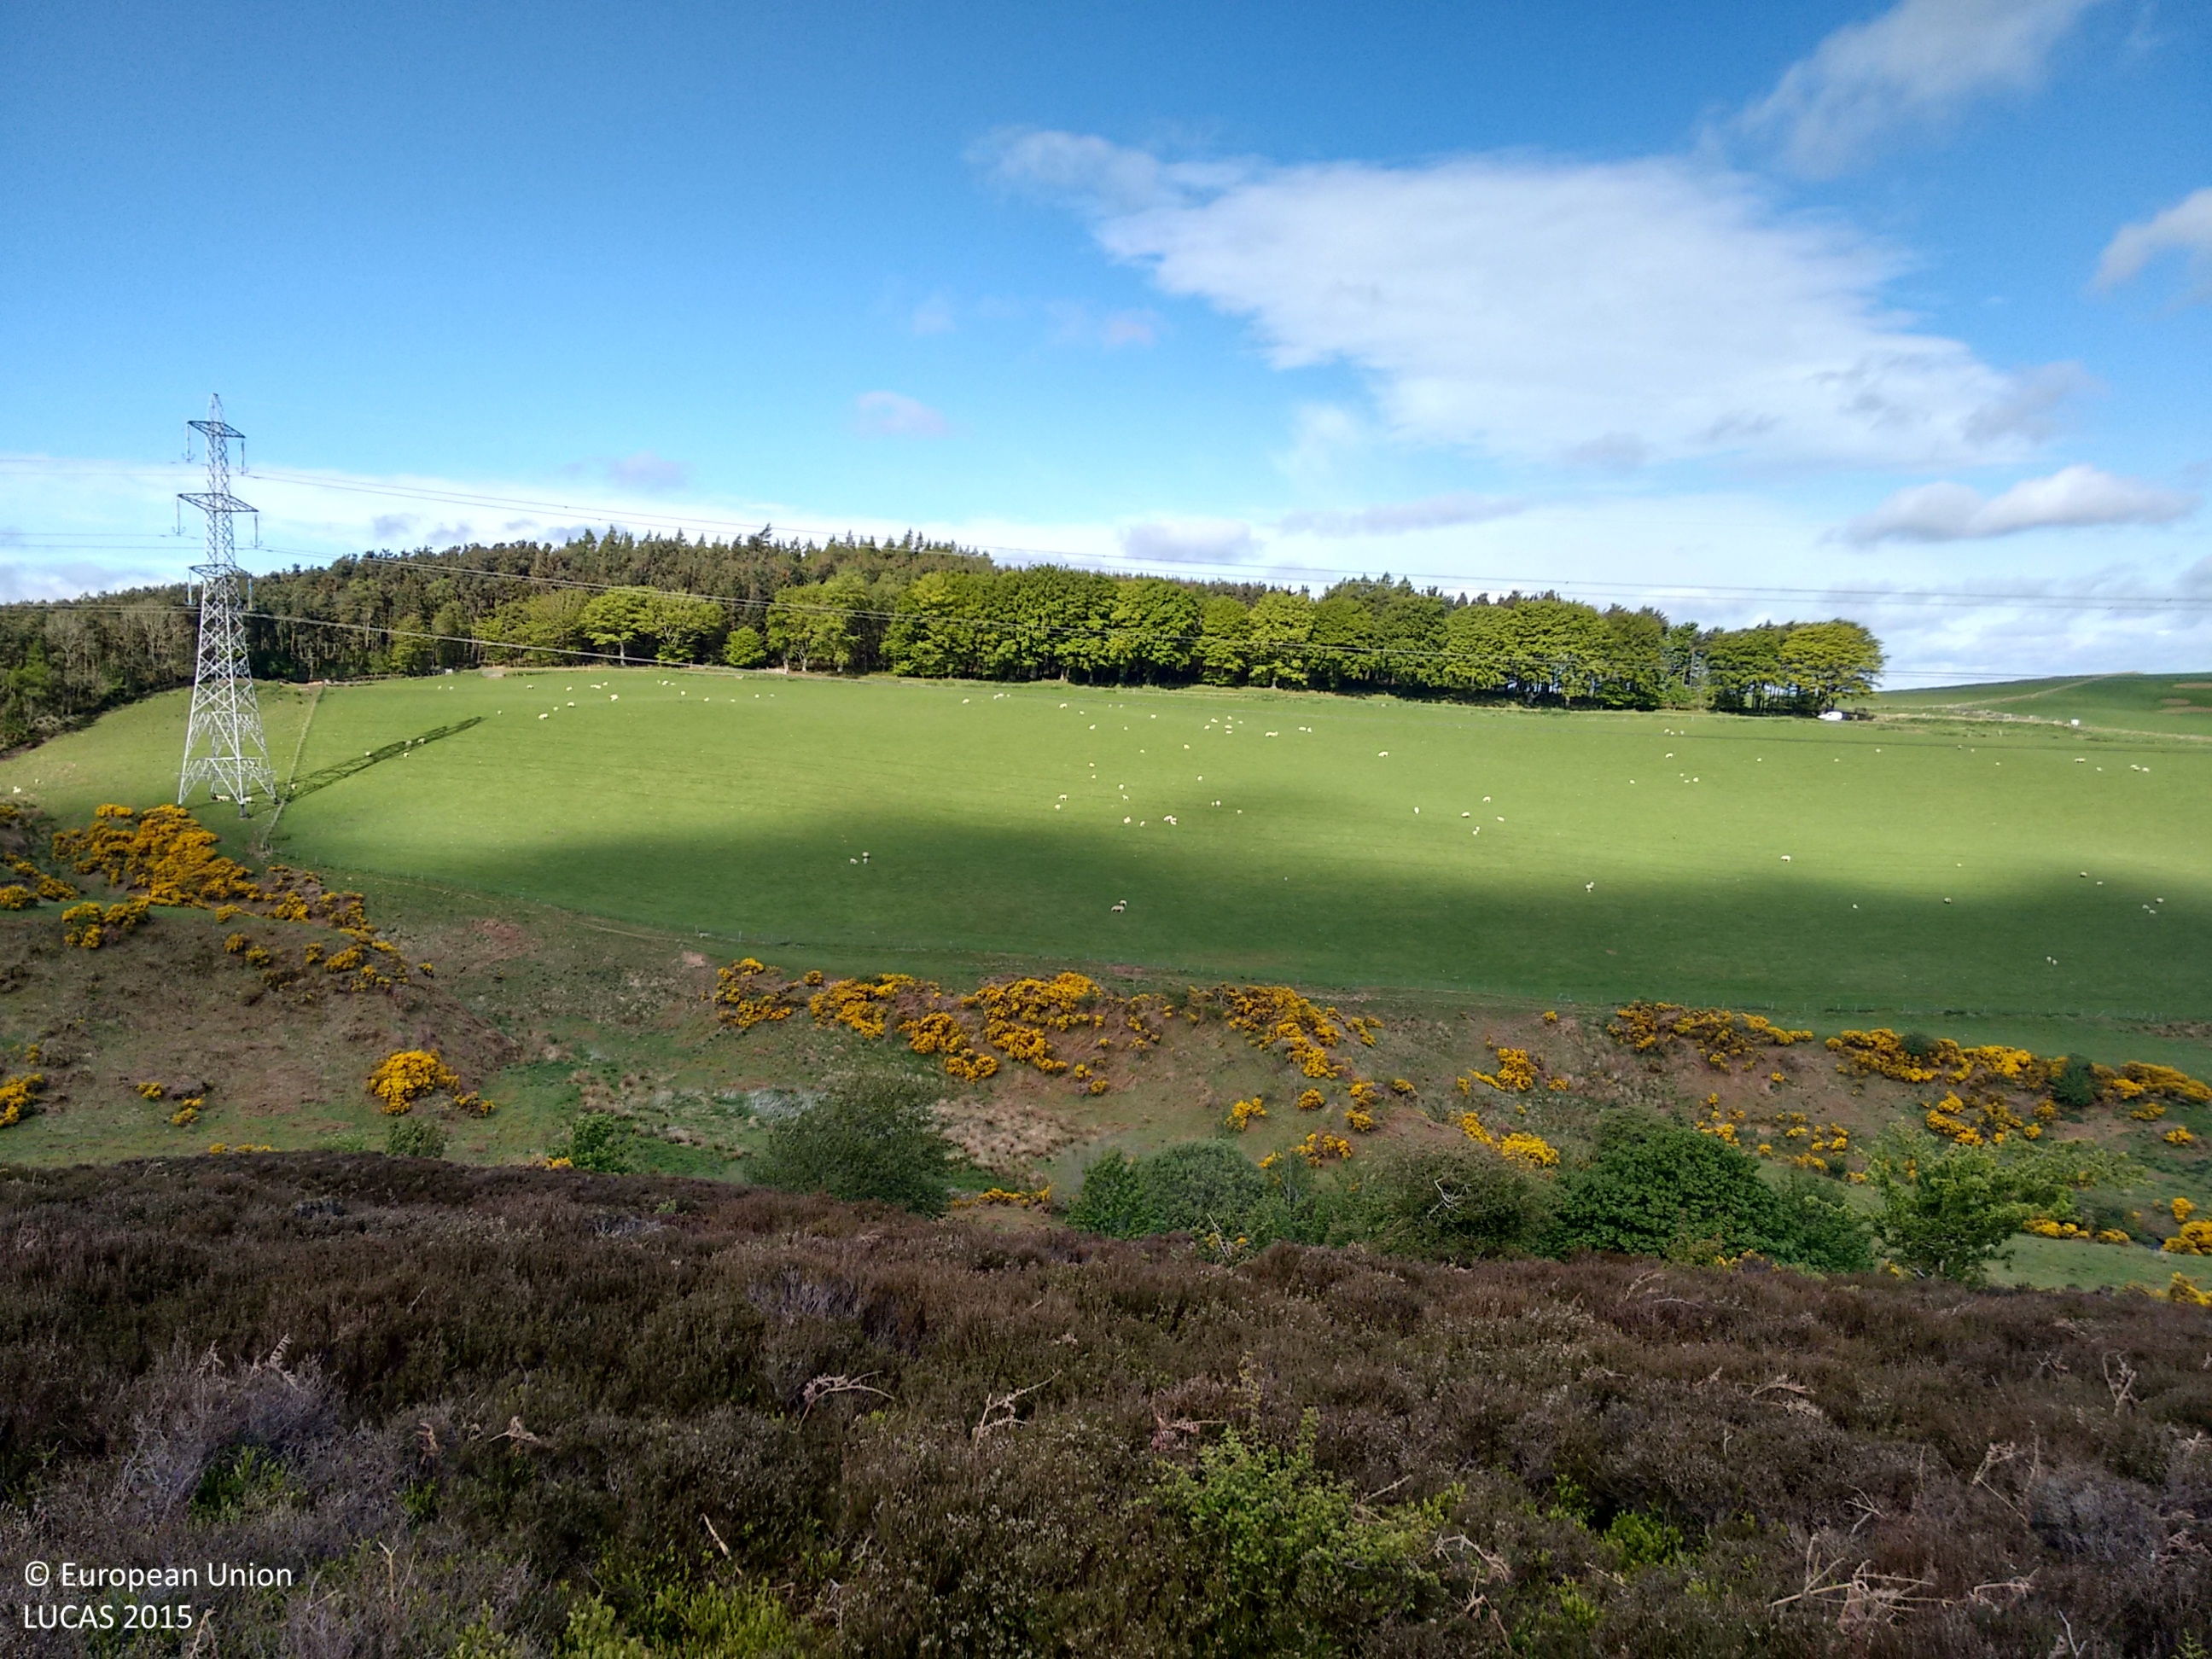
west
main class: Shrubland
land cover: Shrubland without tree cover
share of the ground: > 75 %
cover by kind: shrubs 80 %, herbaceous plants 20 %
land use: Agriculture (excluding fallow land and kitchen gardens)
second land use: Other primary production
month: June
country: GB
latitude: 55.8536
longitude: -2.7963
